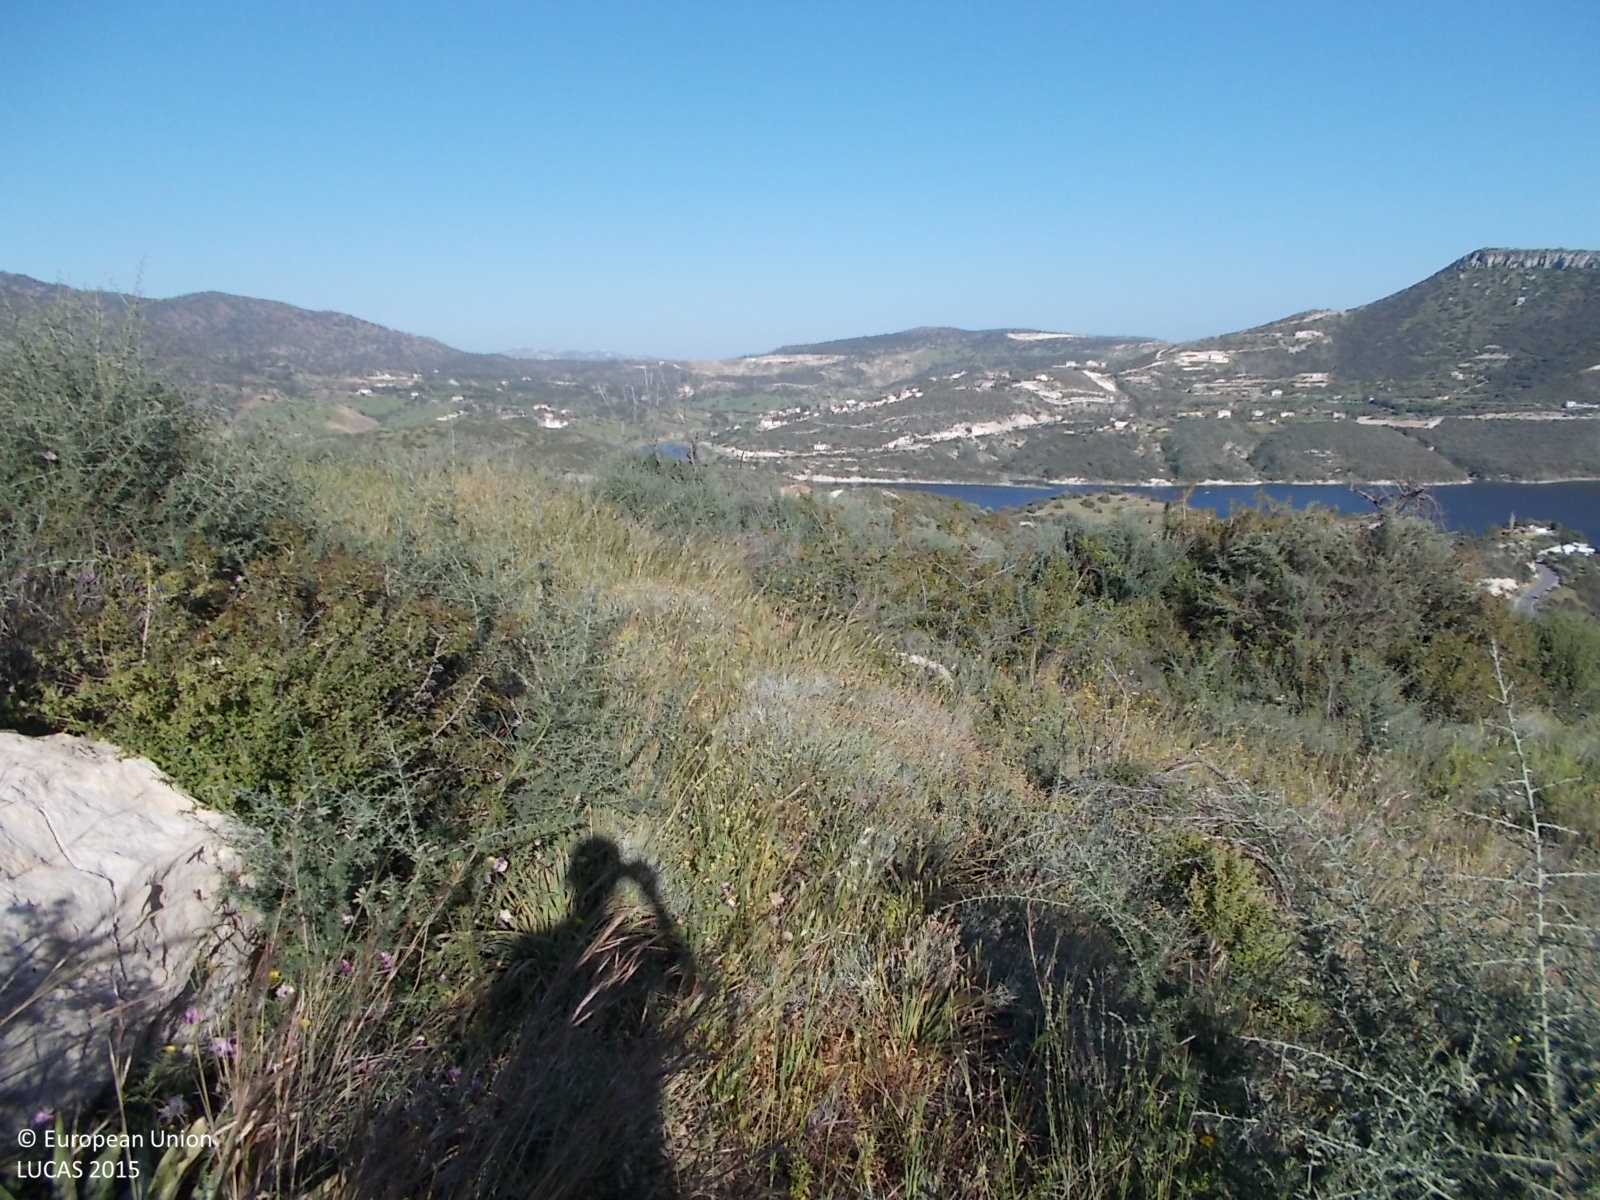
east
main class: Shrubland
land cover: Shrubland without tree cover
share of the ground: 50 - 75 %
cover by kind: shrubs 60 %, herbaceous plants 35 %, consolidated bare surface 5 %
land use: Semi-natural and natural areas not in use
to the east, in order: Shrubland without tree cover; Grassland with sparse tree/shrub cover; Shrubland without tree cover; Grassland with sparse tree/shrub cover; Tracks; Shrubland without tree cover
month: April
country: CY
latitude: 34.7555
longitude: 33.0770
